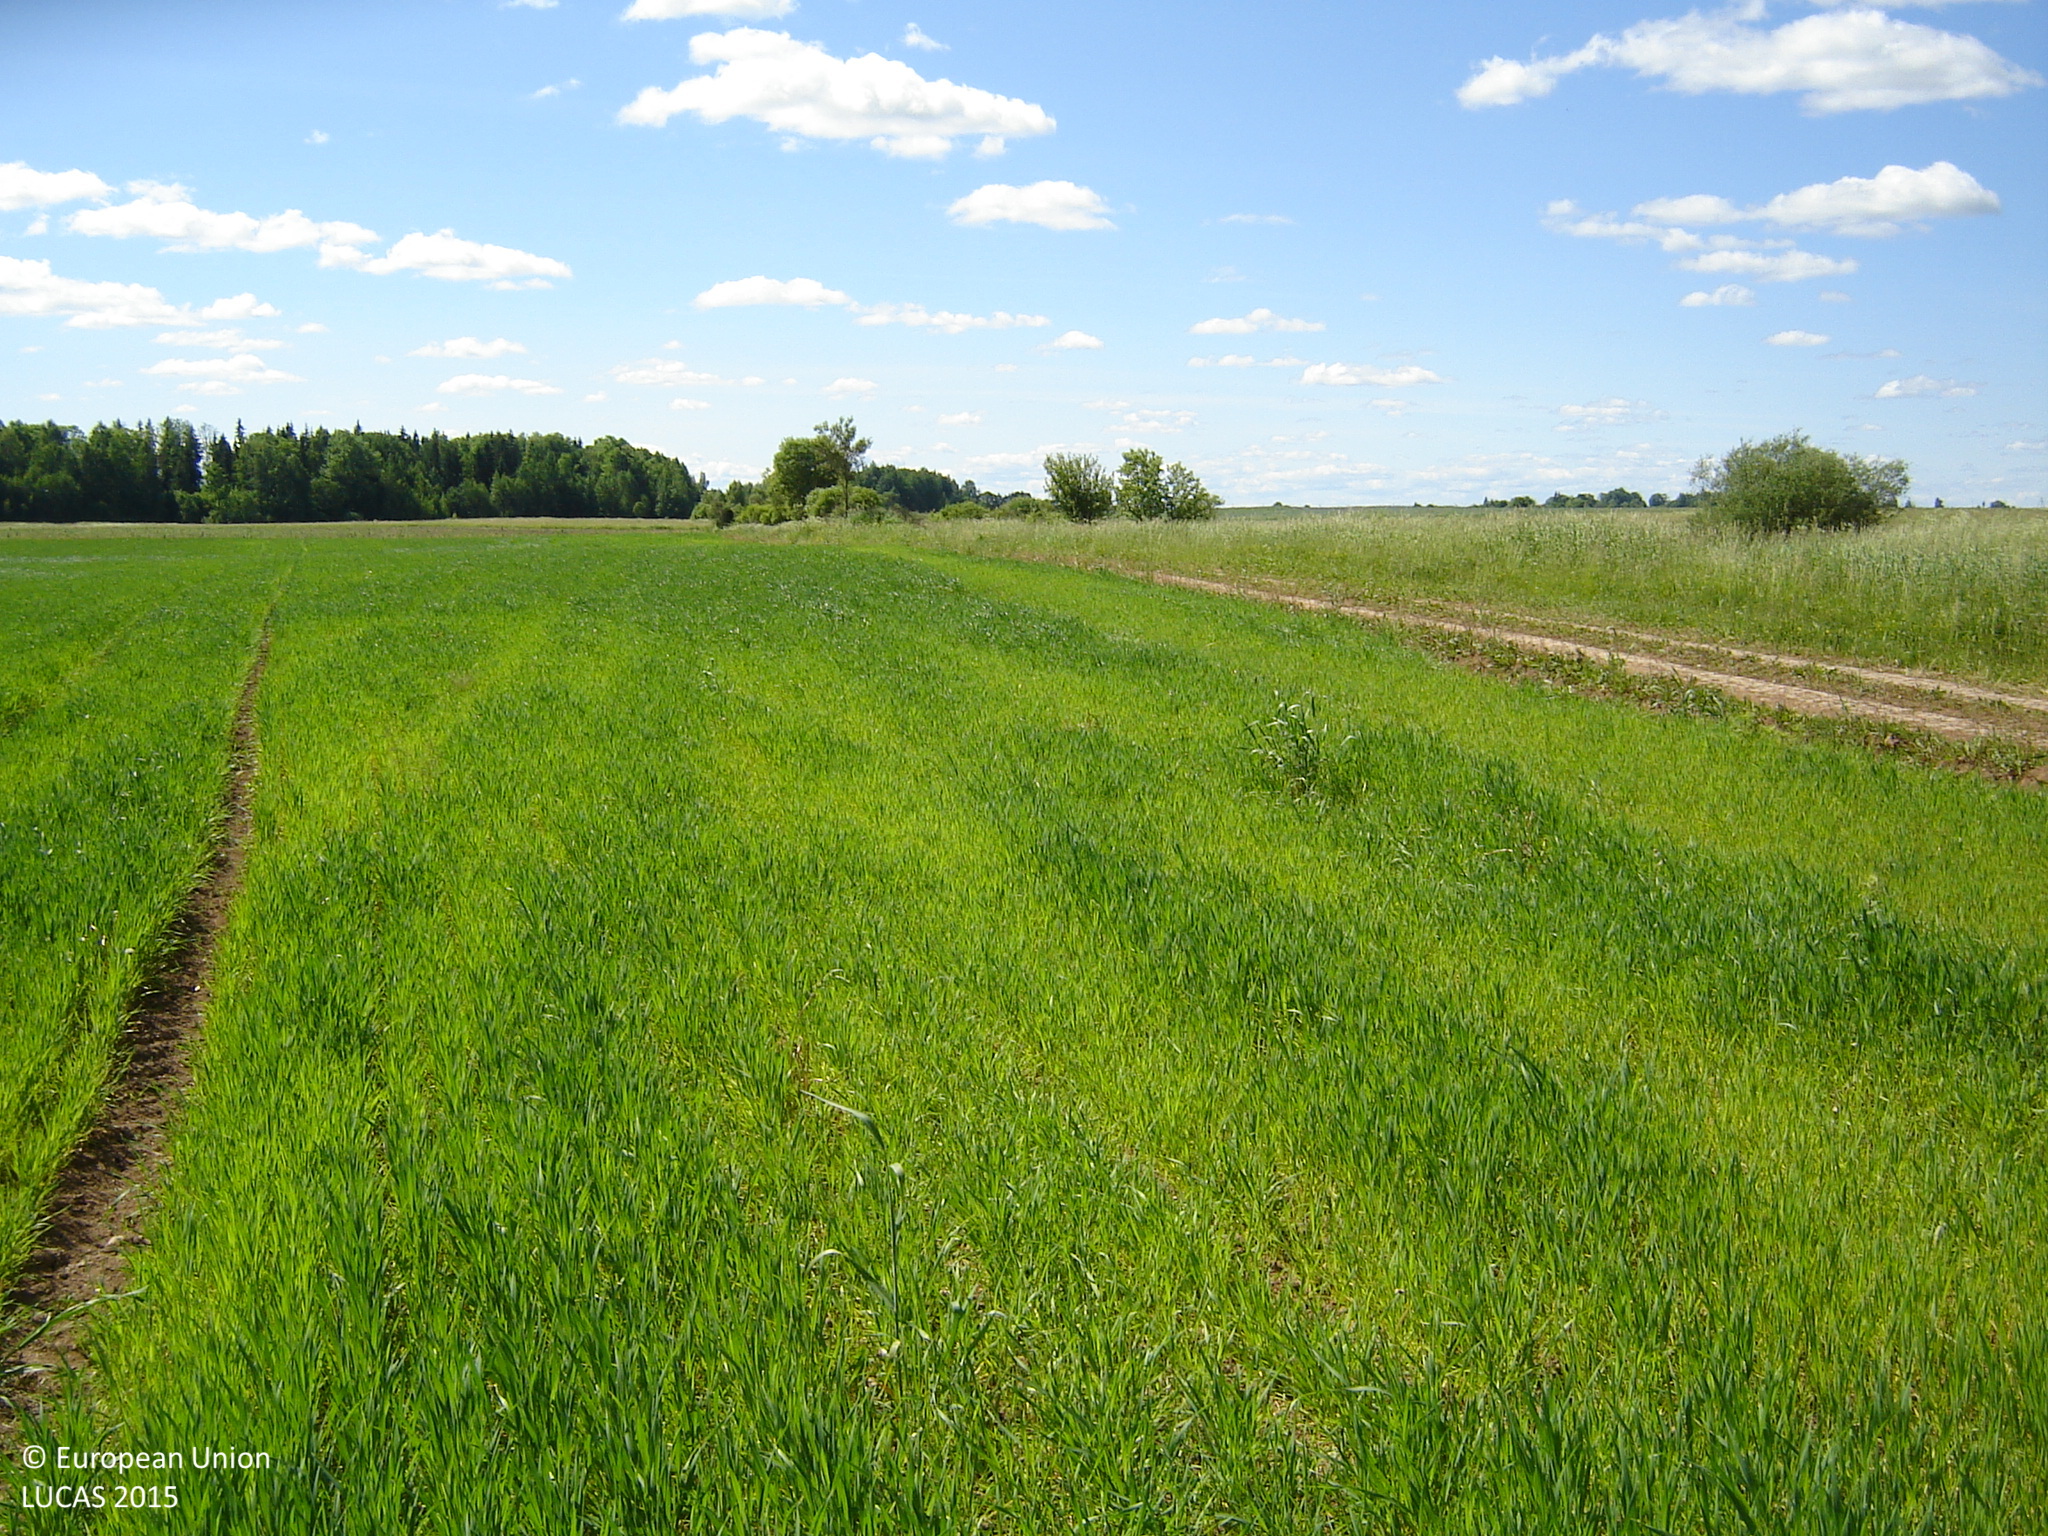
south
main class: Cropland
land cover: Common wheat
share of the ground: > 75 %
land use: Agriculture (excluding fallow land and kitchen gardens)
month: June
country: LT
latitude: 55.2944
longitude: 26.4838
